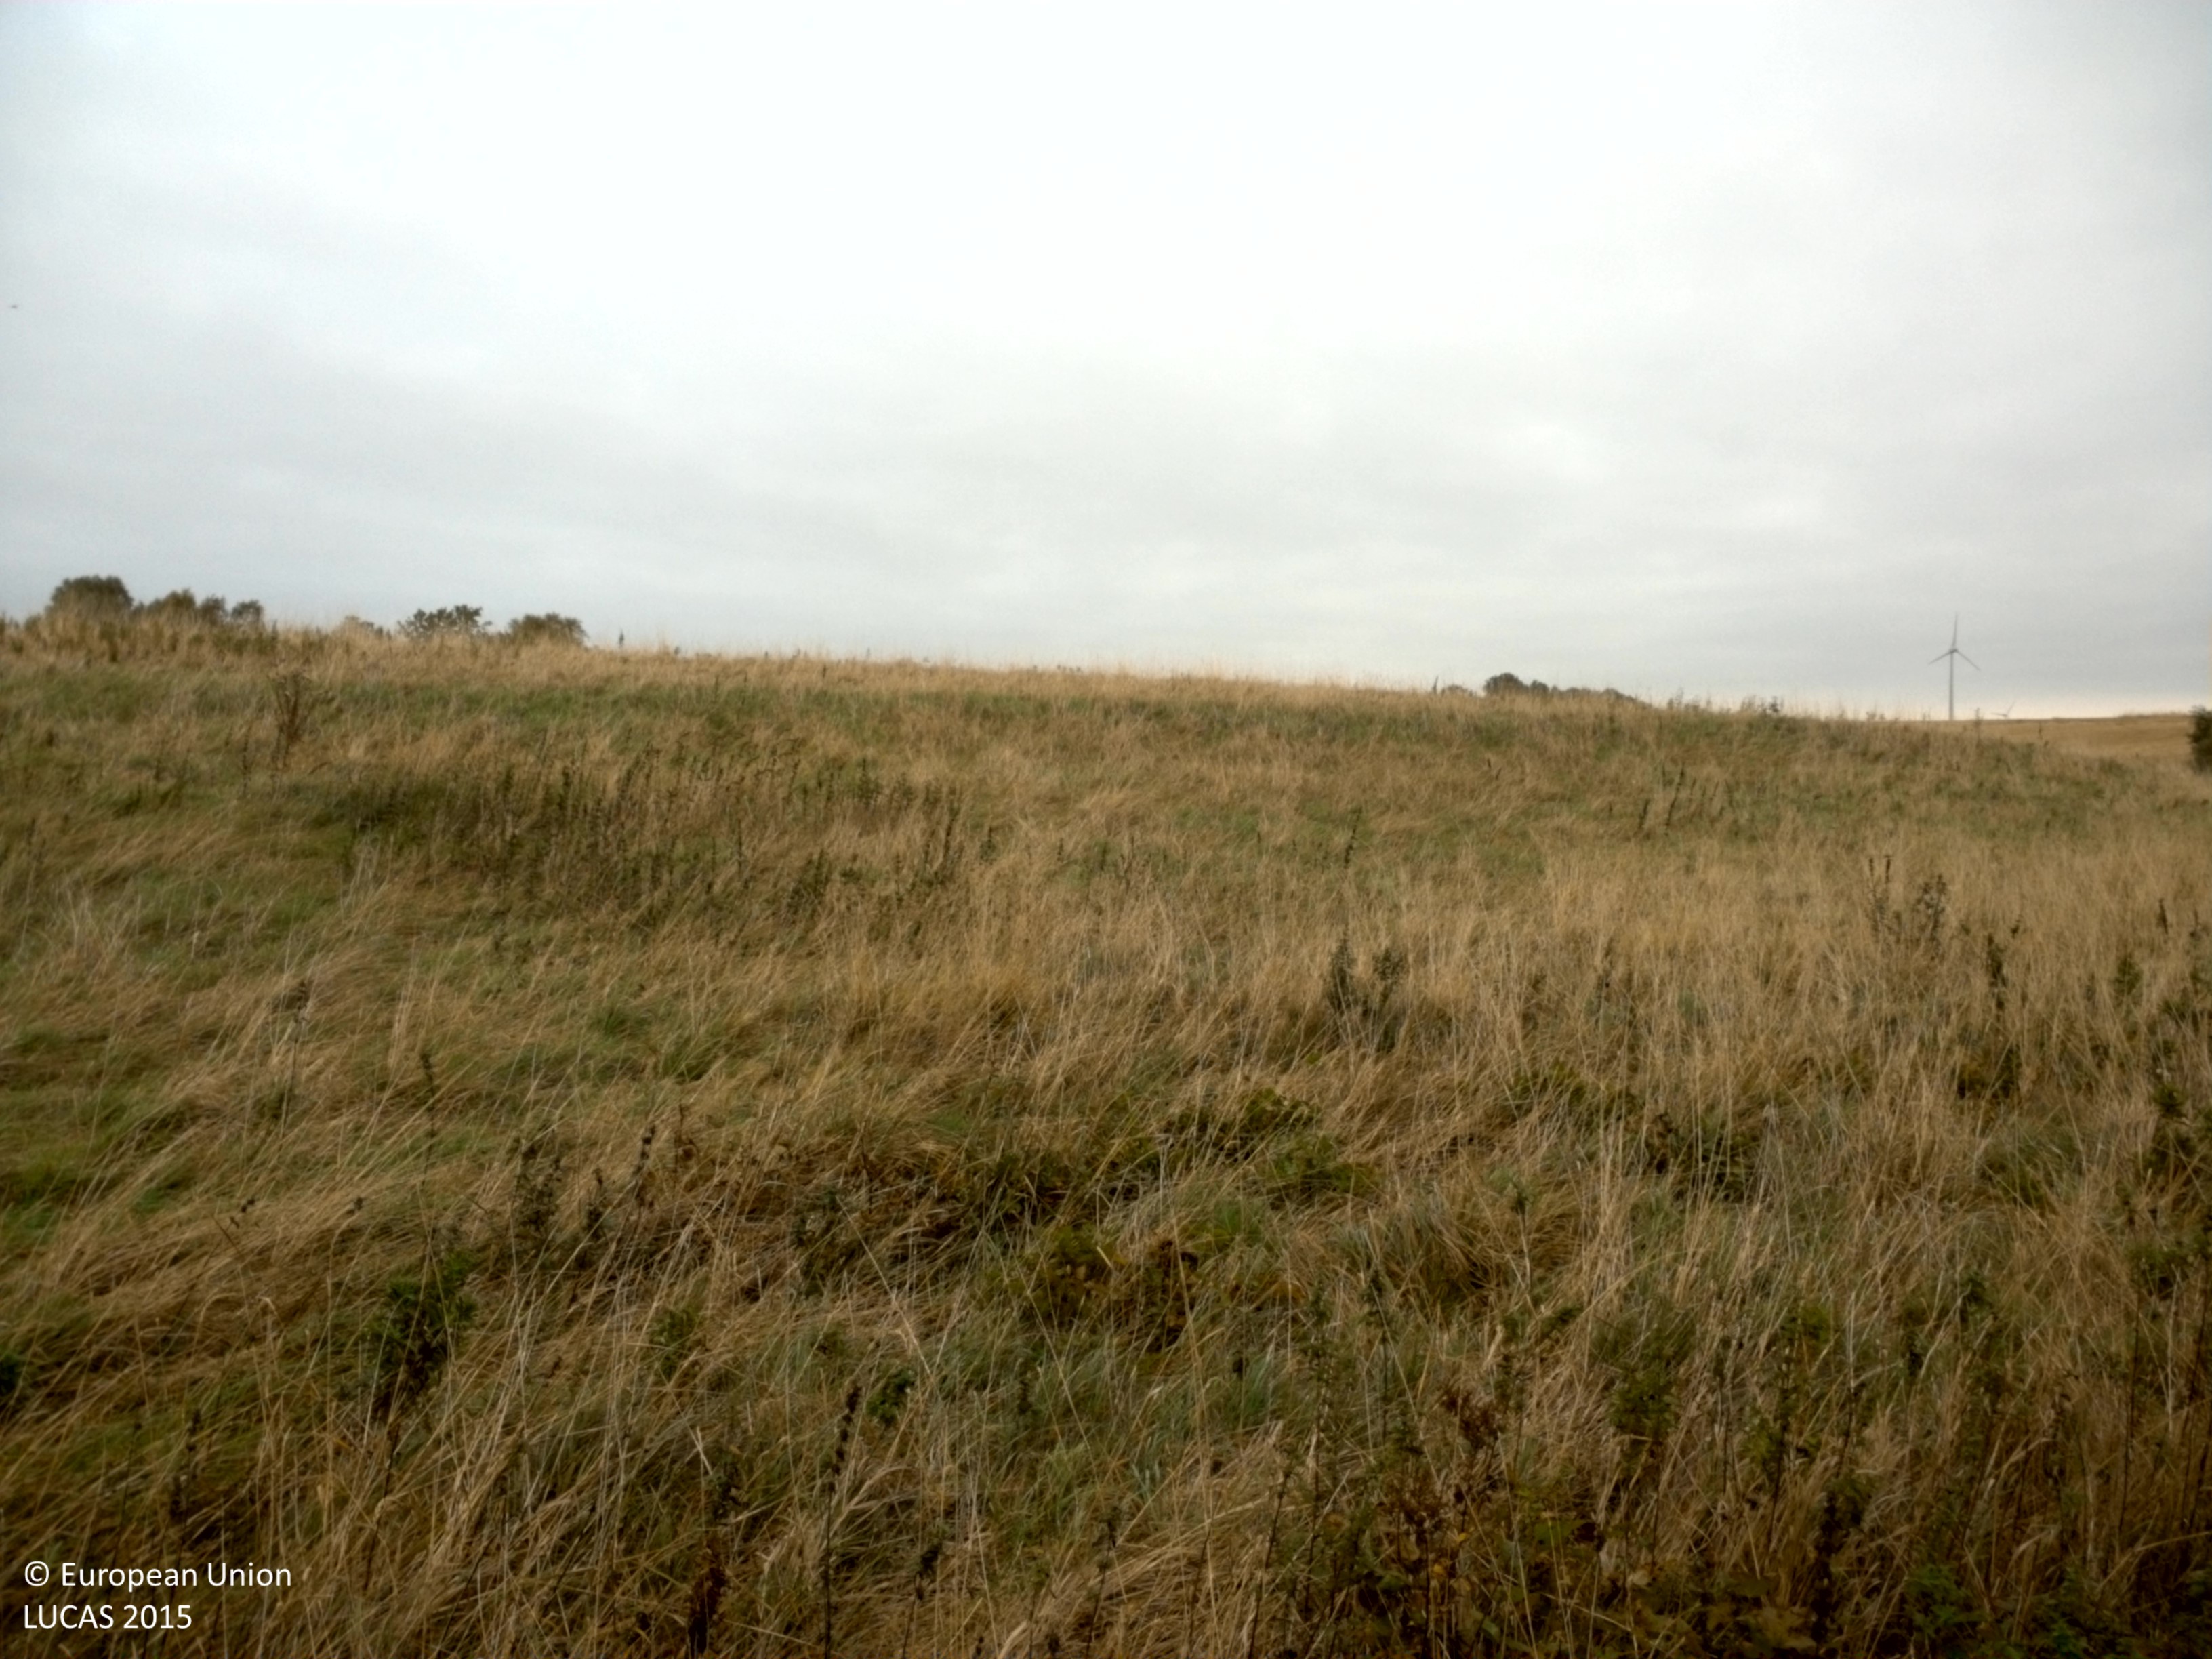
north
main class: Grassland
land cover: Grassland without tree/shrub cover
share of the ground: > 75 %
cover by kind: herbaceous plants 100 %
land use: Semi-natural and natural areas not in use
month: October
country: SE
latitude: 58.3132
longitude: 12.9476
